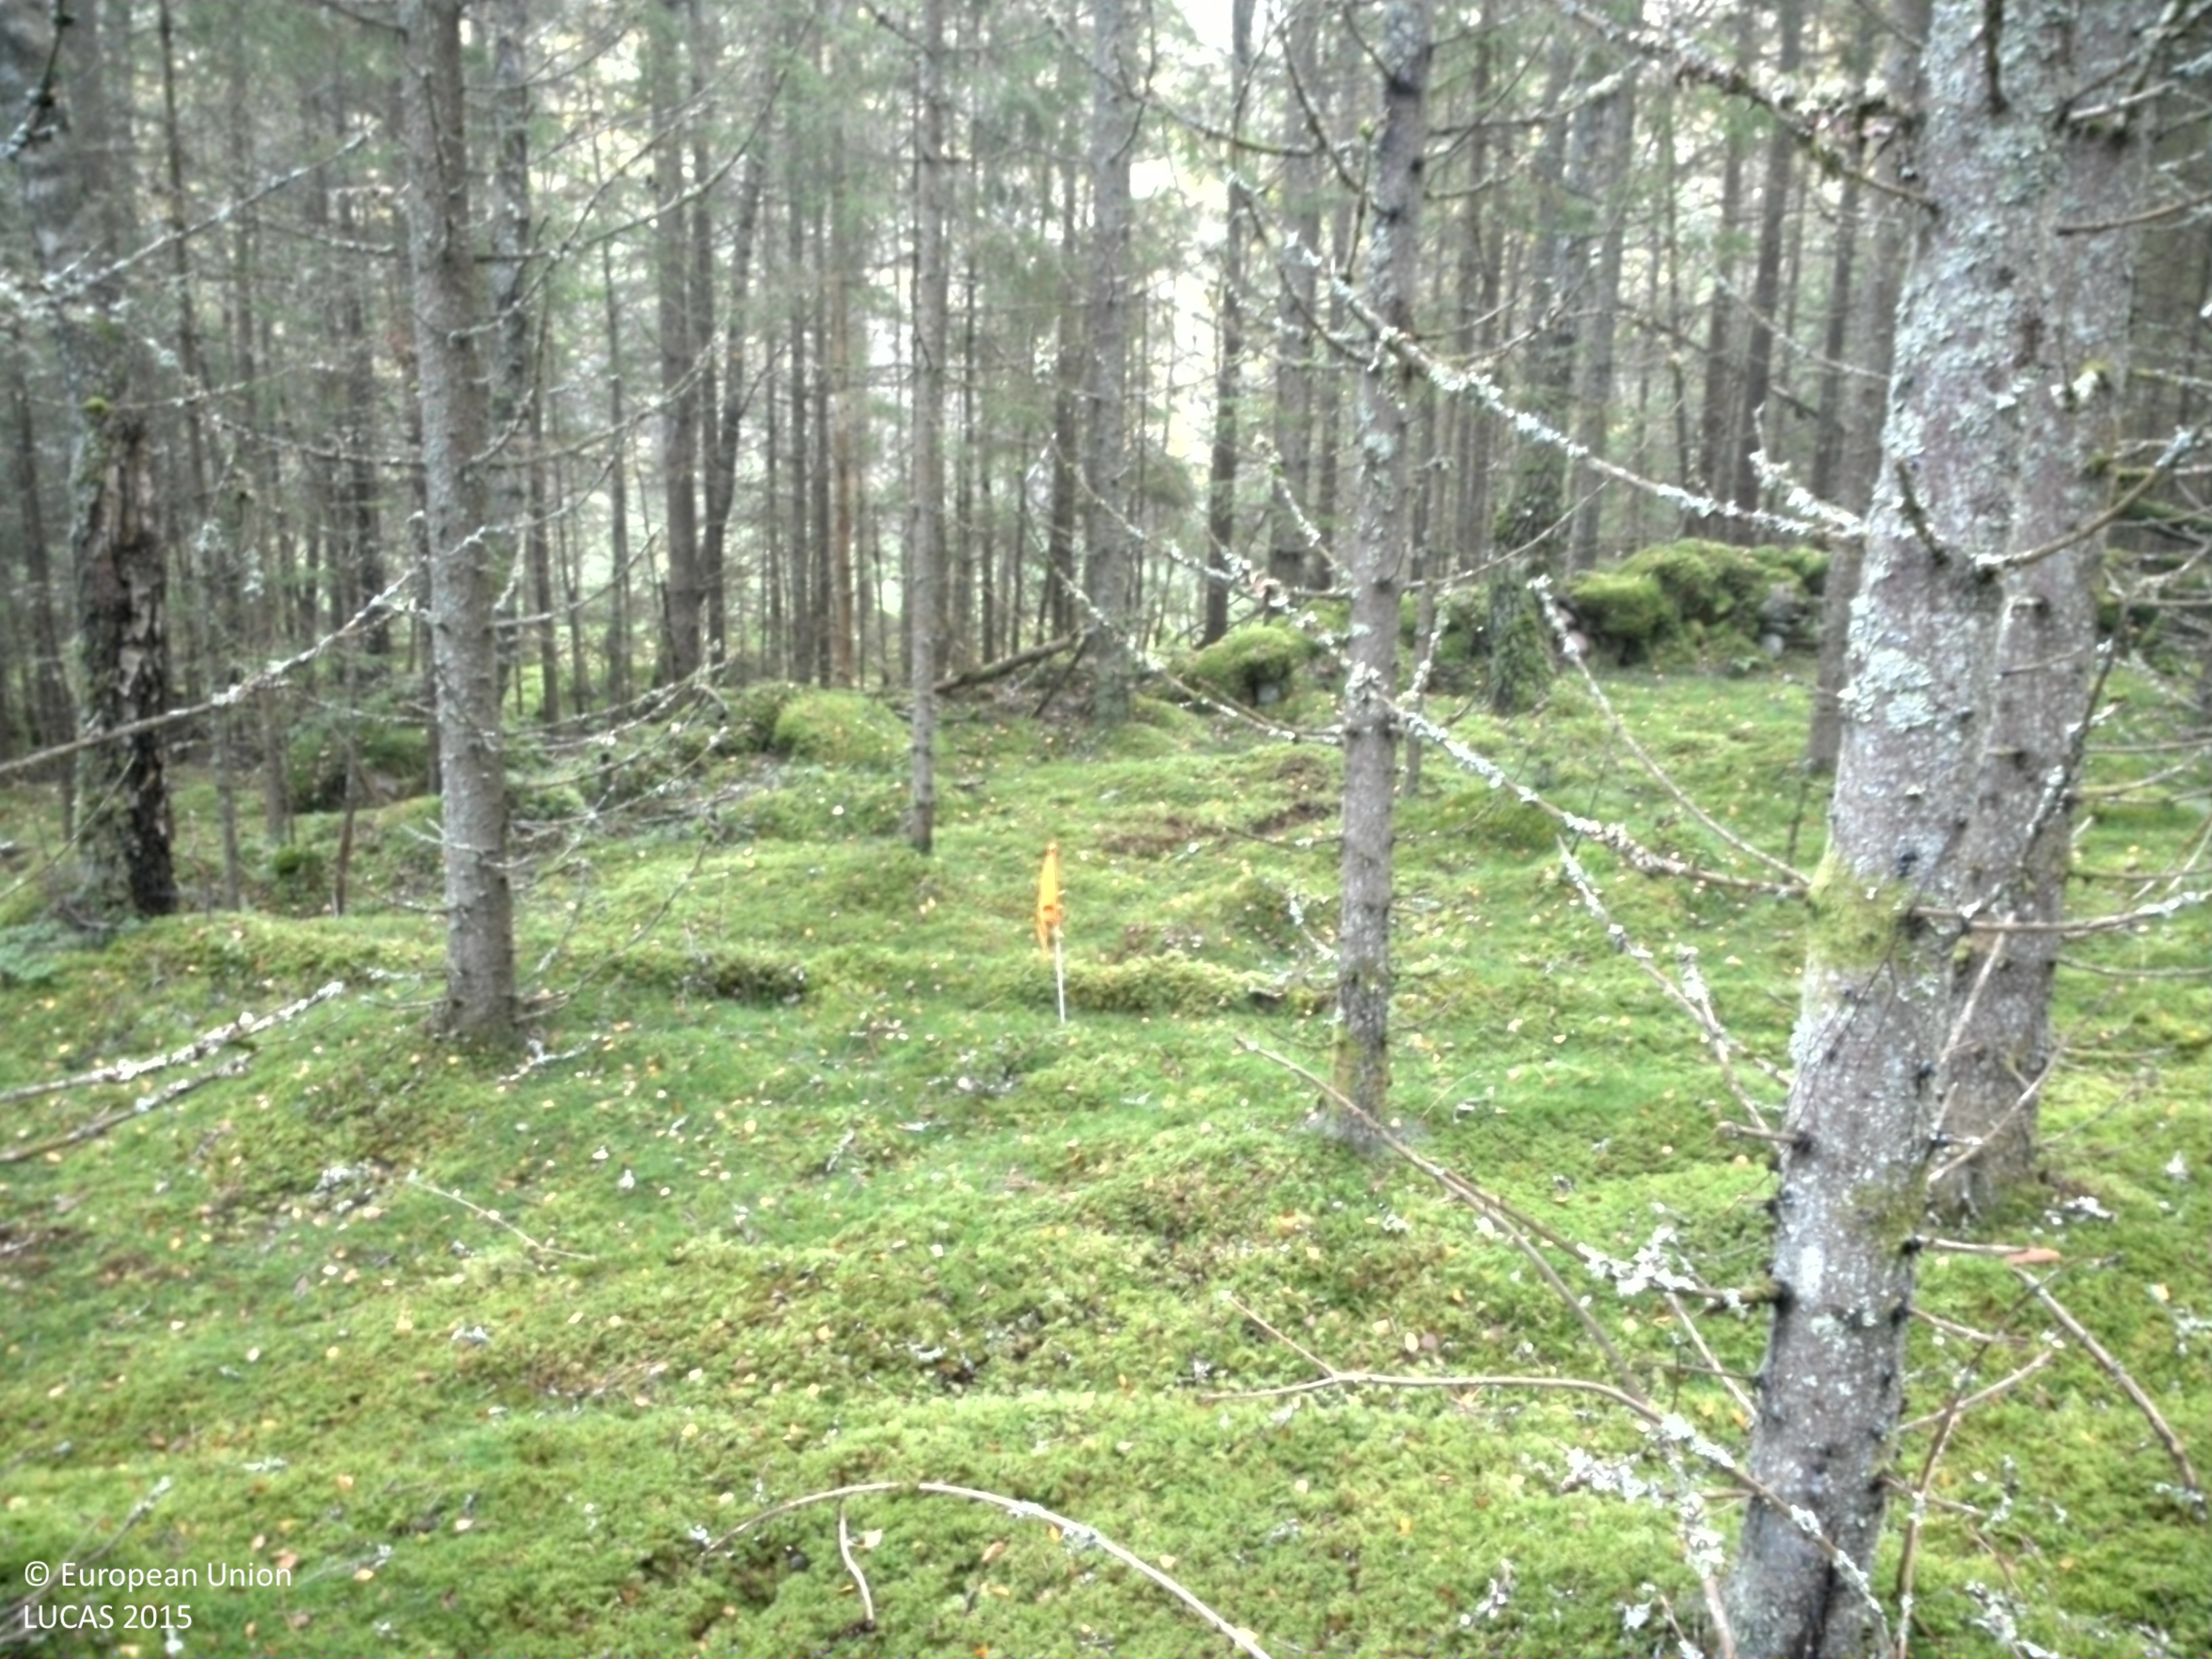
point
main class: Woodland
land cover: Spruce dominated coniferous woodland
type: boreal forest
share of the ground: > 75 %
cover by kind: coniferous forest trees 75 %, lichens and mosses 25 %
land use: Forestry
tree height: > 5 m
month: September
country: SE
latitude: 57.8743
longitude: 13.2491
